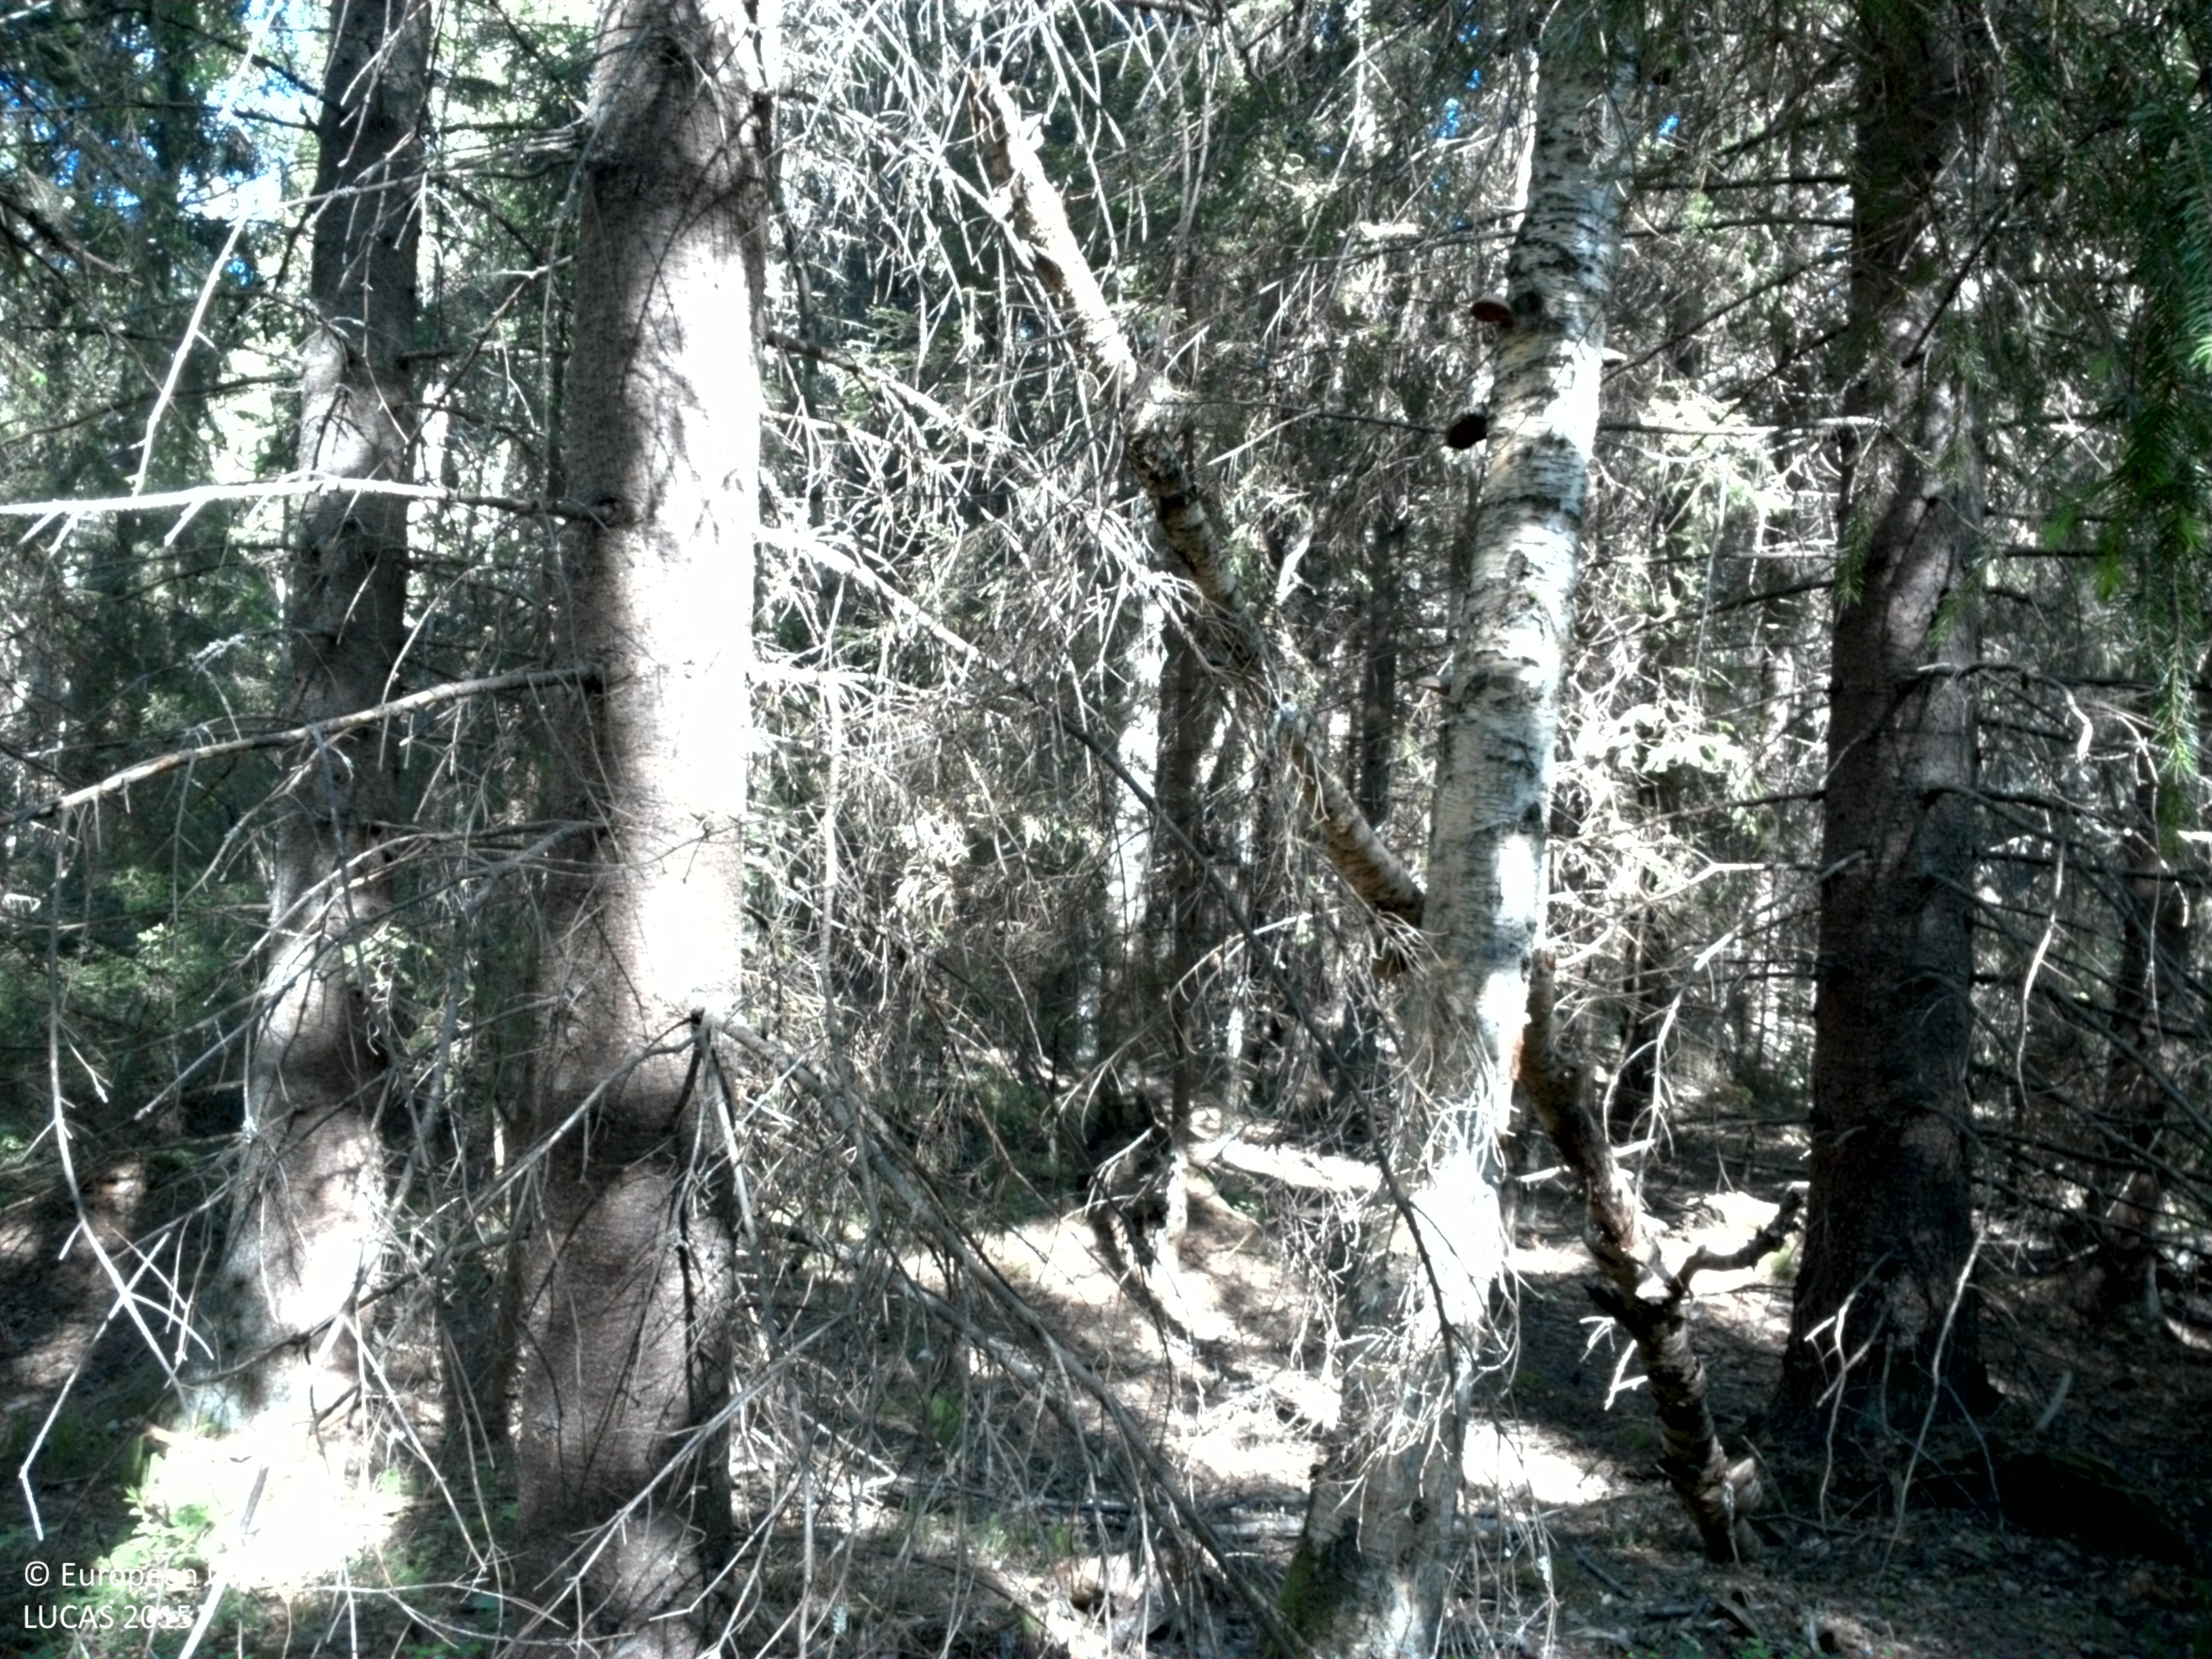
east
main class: Woodland
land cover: Spruce dominated mixed woodland
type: boreal forest
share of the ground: > 75 %
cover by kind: coniferous forest trees 60 %, broadleaved forest trees 20 %, shrubs 10 %, herbaceous plants 10 %
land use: Forestry
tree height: > 5 m
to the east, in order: Spruce dominated mixed woodland; Broadleaved woodland; Ditches and canals; Spruce dominated mixed woodland
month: June
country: SE
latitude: 59.9736
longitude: 18.8682
